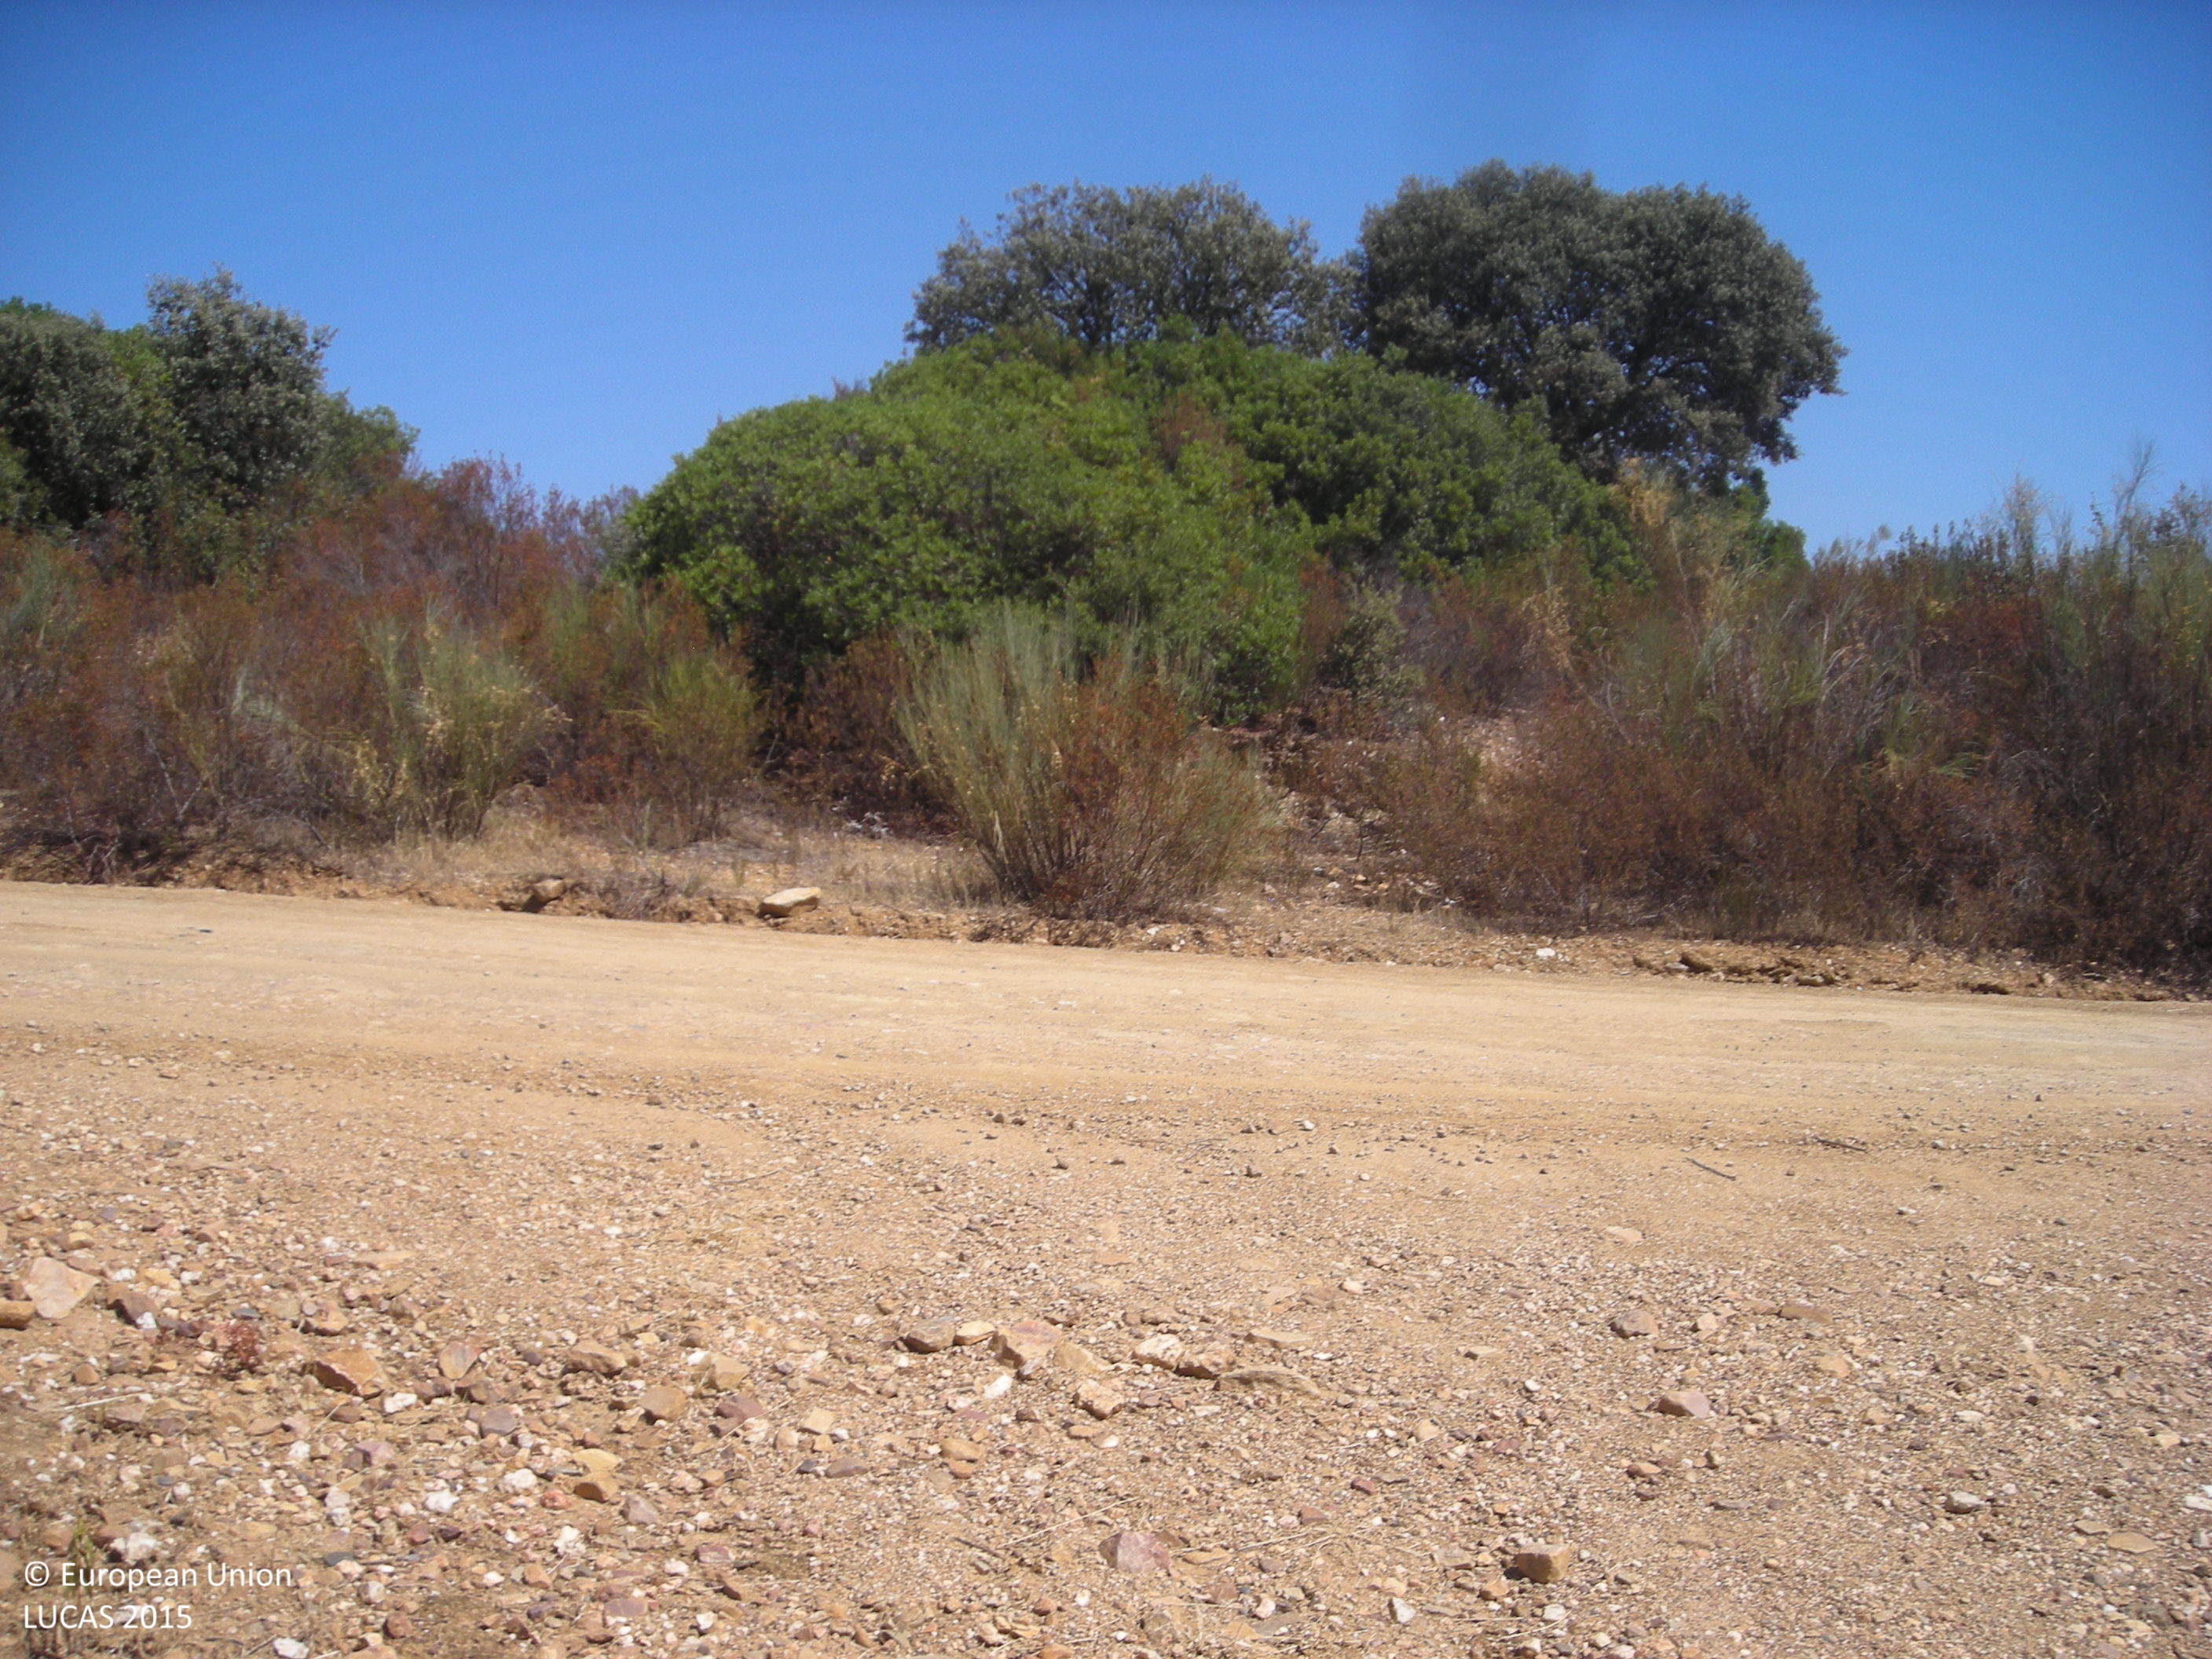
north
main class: Grassland
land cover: Grassland without tree/shrub cover
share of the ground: > 75 %
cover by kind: herbaceous plants 100 %
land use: Agriculture (excluding fallow land and kitchen gardens)
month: July
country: ES
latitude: 38.7740
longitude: -5.9198
